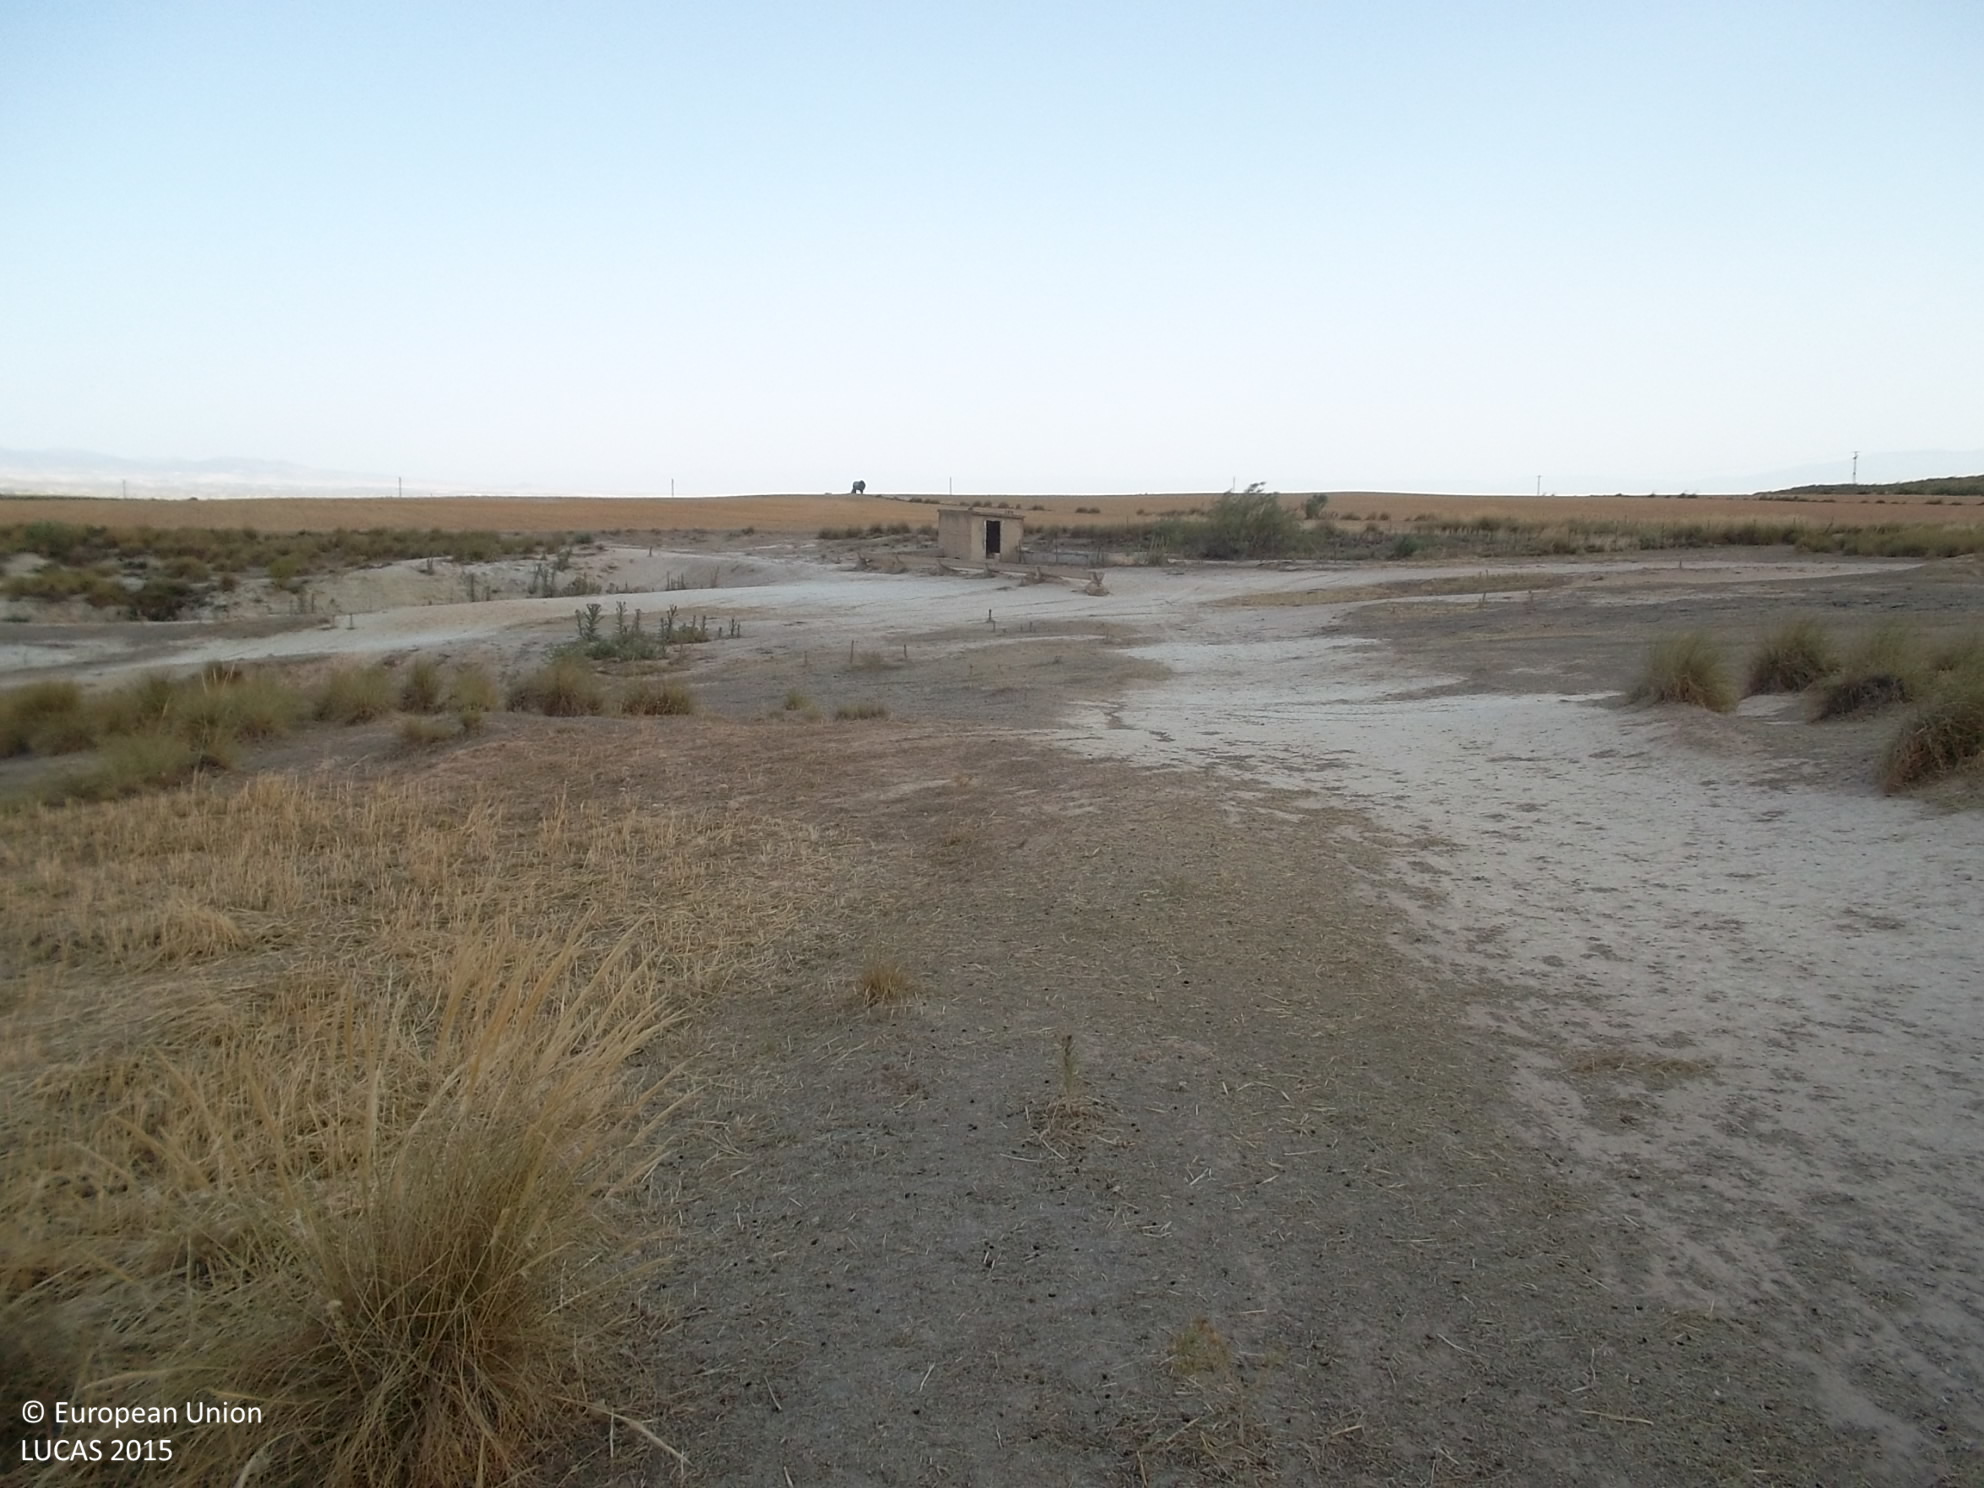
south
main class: Grassland
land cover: Grassland without tree/shrub cover
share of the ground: 50 - 75 %
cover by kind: herbaceous plants 65 %, unconsolidated bare surface 35 %
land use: Agriculture (excluding fallow land and kitchen gardens)
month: July
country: ES
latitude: 37.6776
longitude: -2.7225
